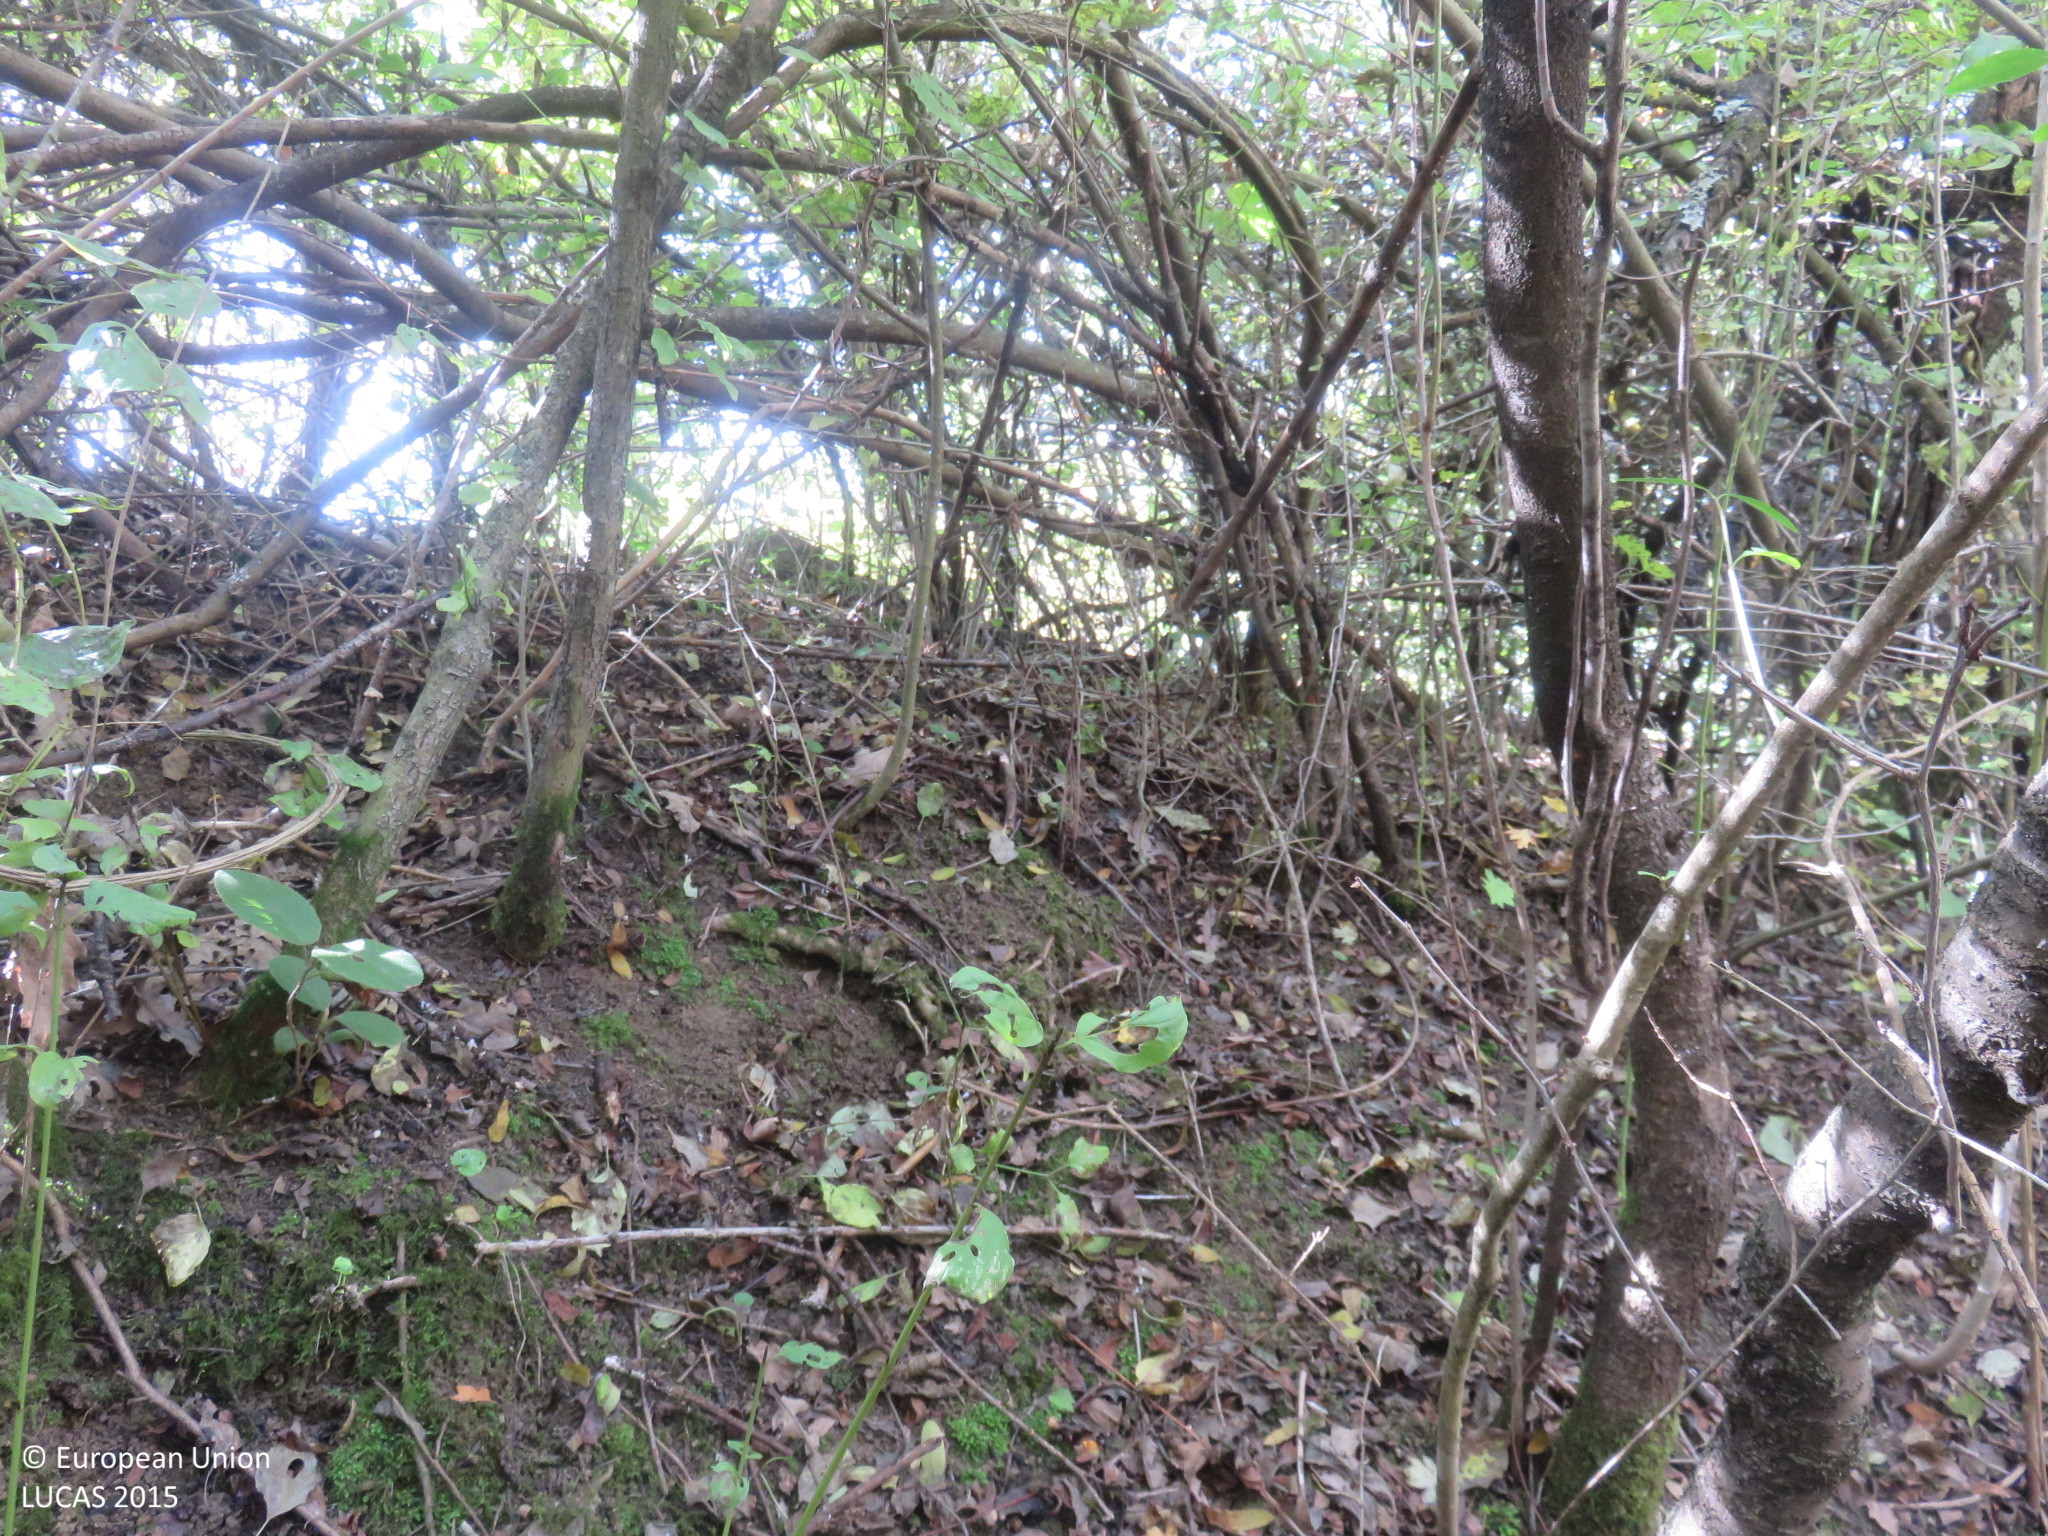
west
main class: Woodland
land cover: Broadleaved woodland
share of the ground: > 75 %
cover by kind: broadleaved forest trees 70 %, shrubs 30 %
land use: Semi-natural and natural areas not in use
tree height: < 5 m
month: October
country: BG
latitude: 42.9657
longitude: 24.8355
